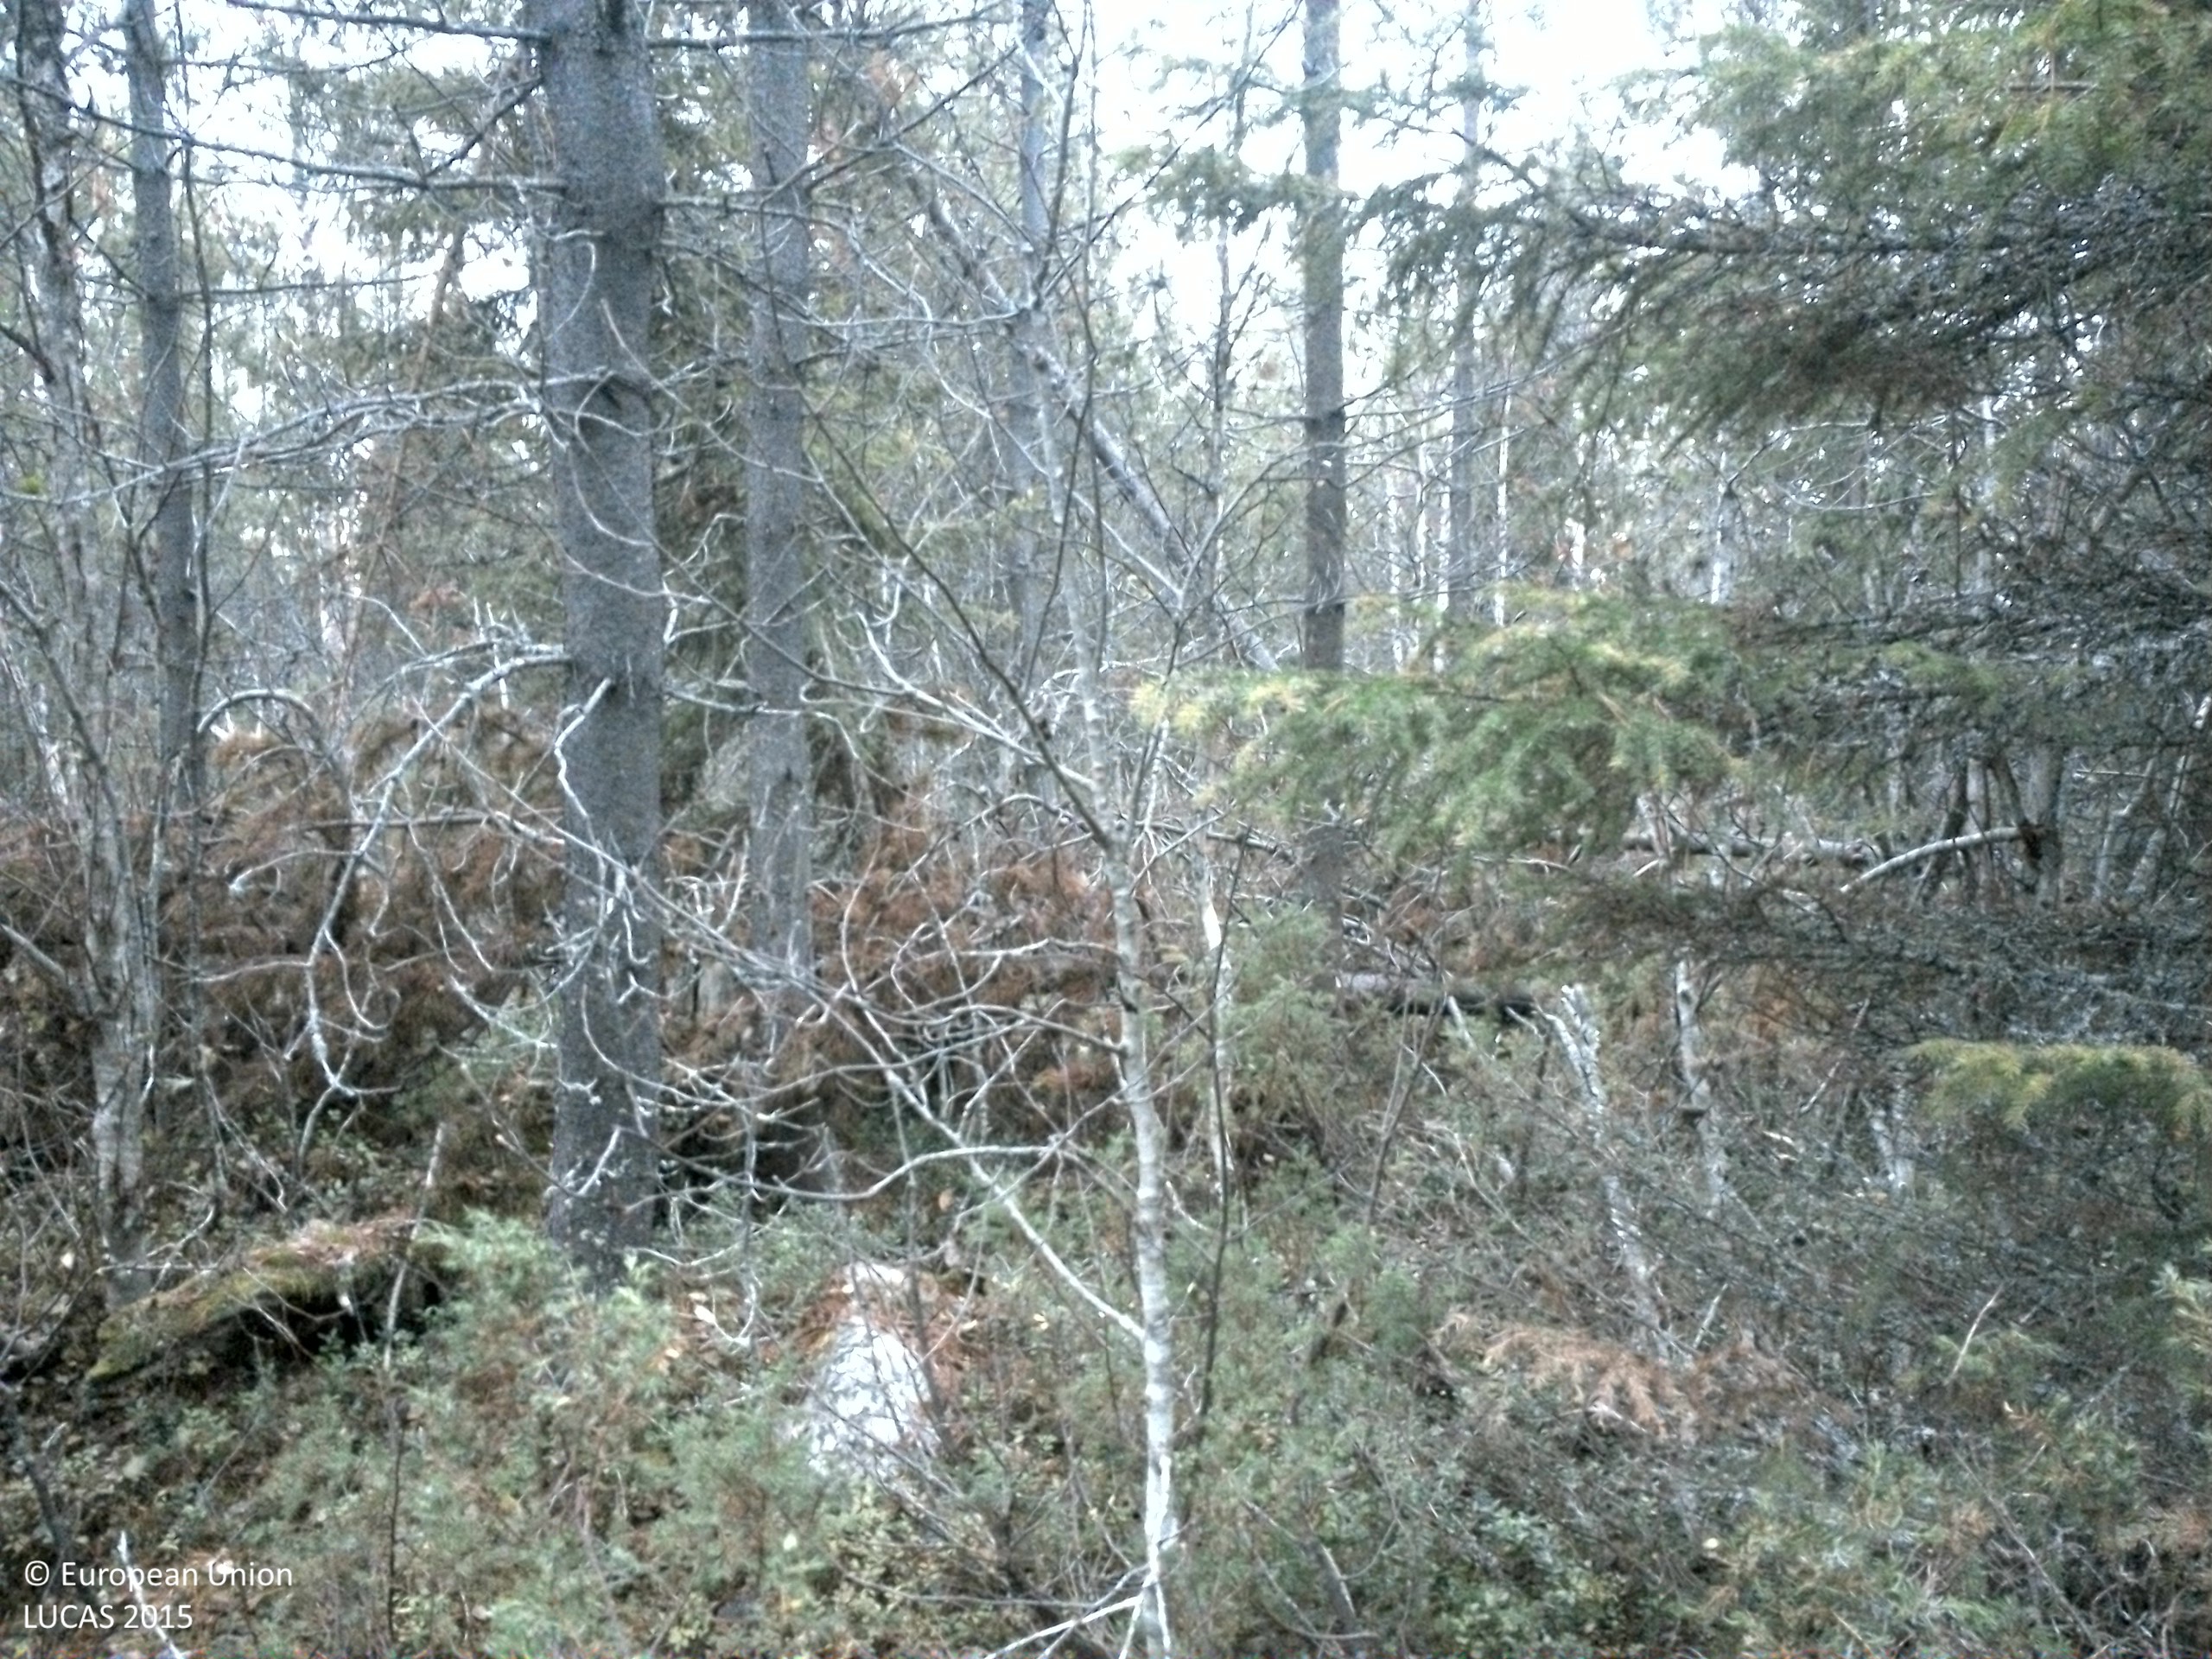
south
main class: Woodland
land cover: Pine dominated mixed woodland
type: exotic forest
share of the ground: 50 - 75 %
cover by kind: coniferous forest trees 40 %, shrubs 25 %, broadleaved forest trees 15 %, lichens and mosses 15 %, herbaceous plants 5 %
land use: Forestry
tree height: > 5 m
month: October
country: SE
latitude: 64.2809
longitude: 15.6093
